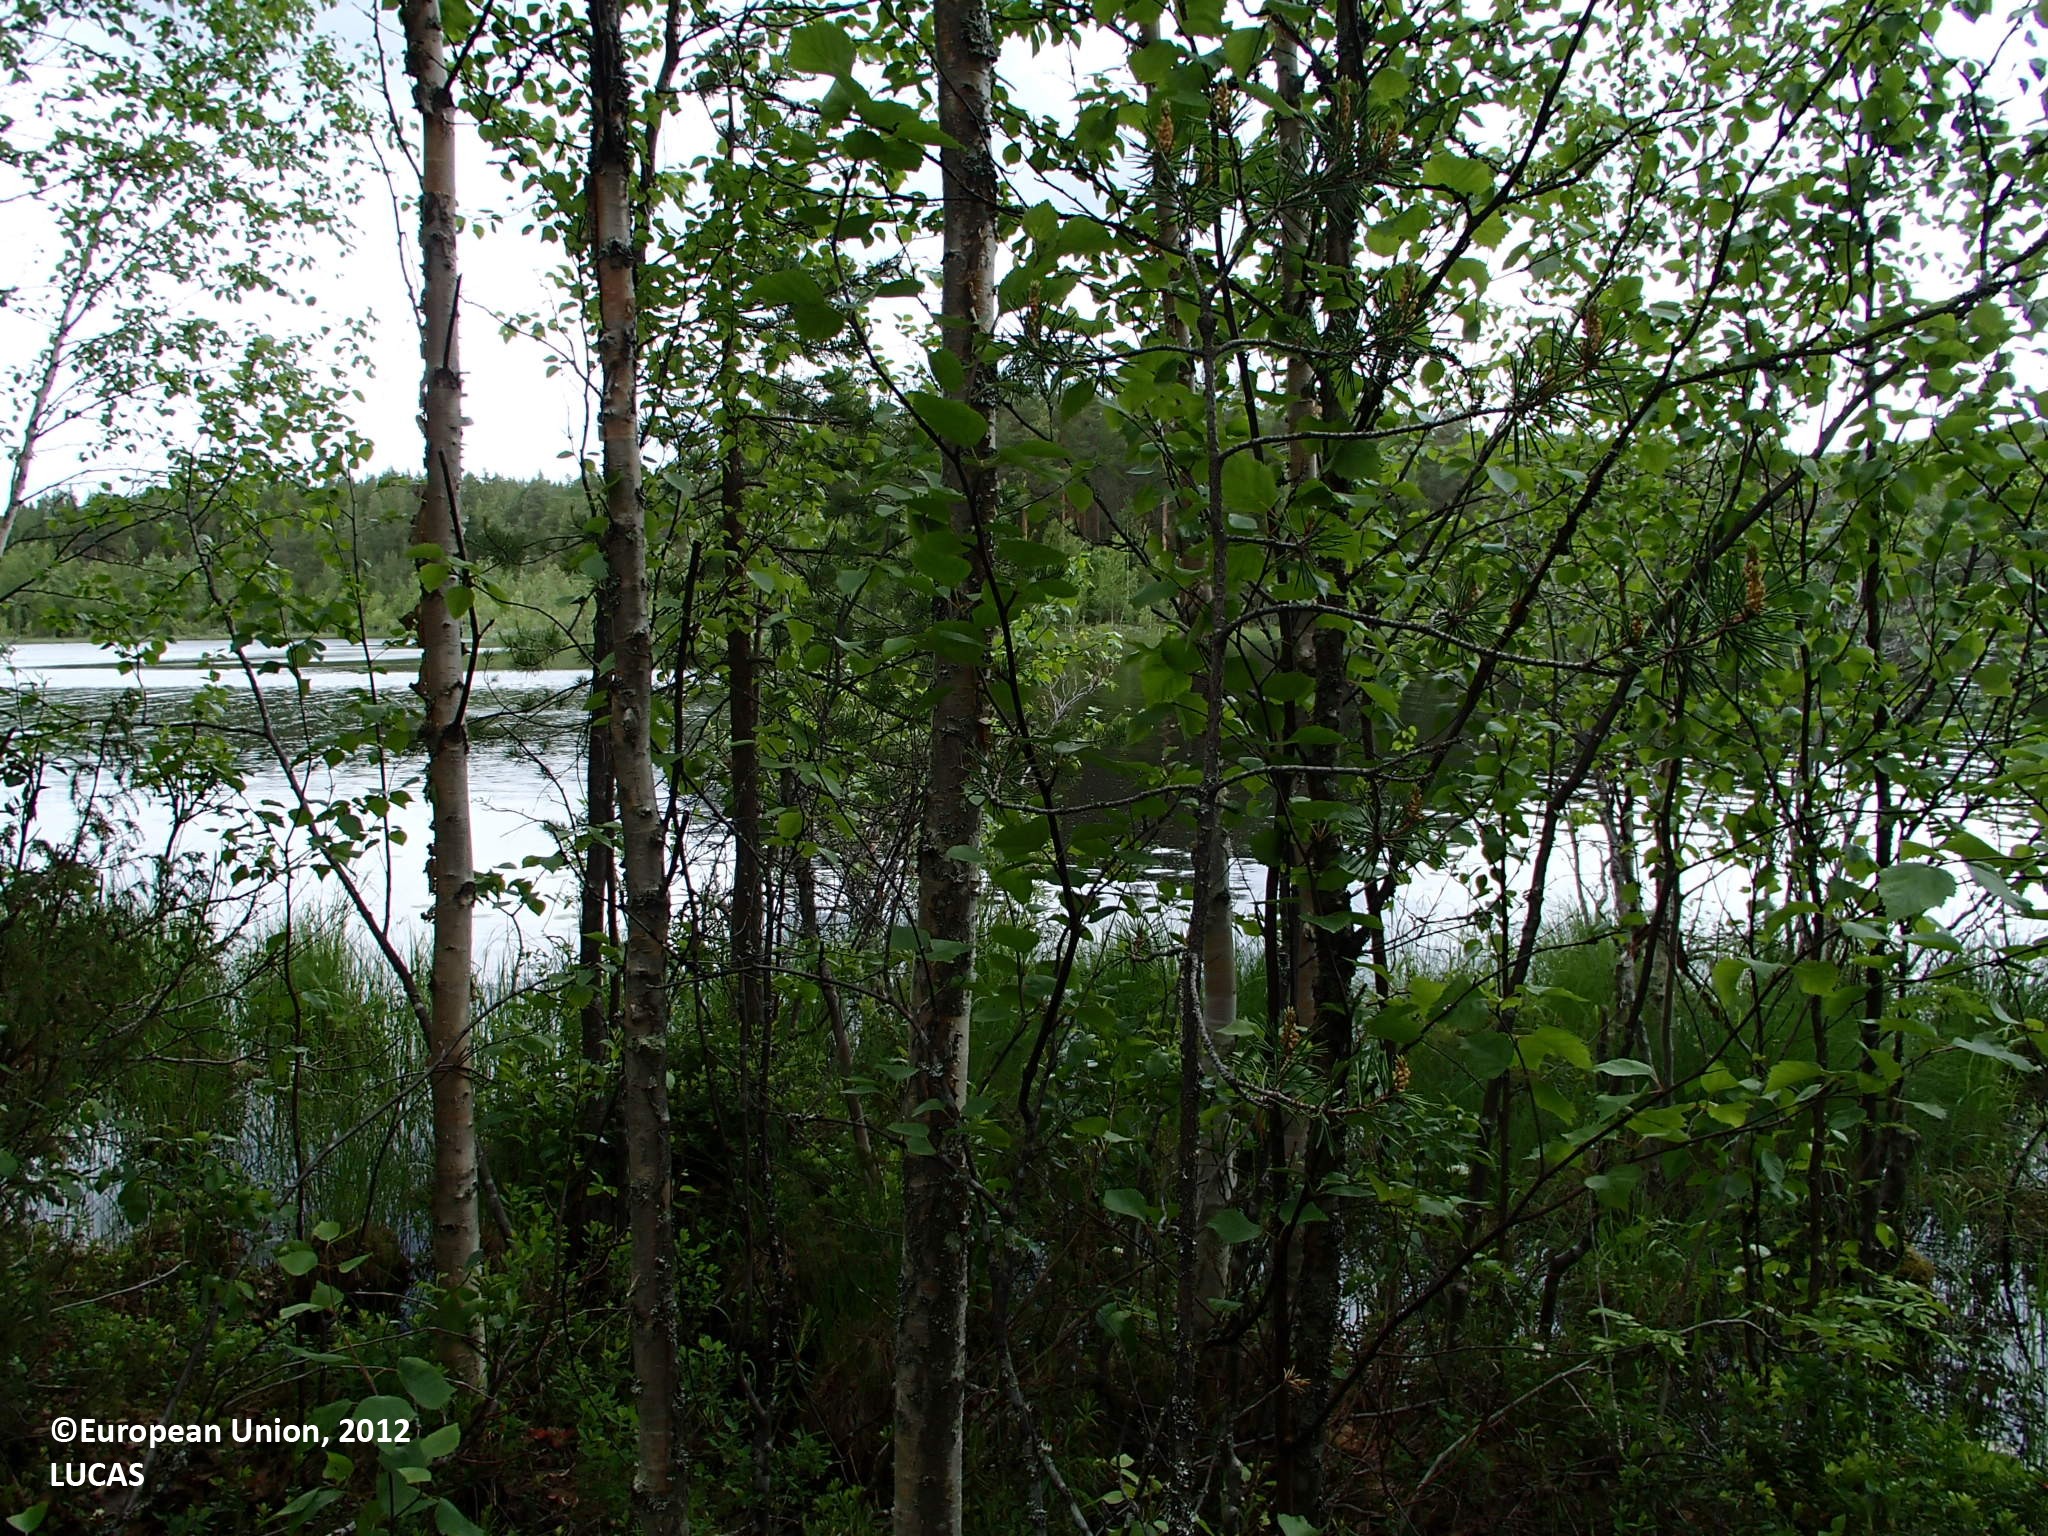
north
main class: Woodland
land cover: Pine dominated mixed woodland
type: boreal forest
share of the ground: > 75 %
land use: Forestry
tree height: > 5 m
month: June
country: FI
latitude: 66.5986
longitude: 27.6952
